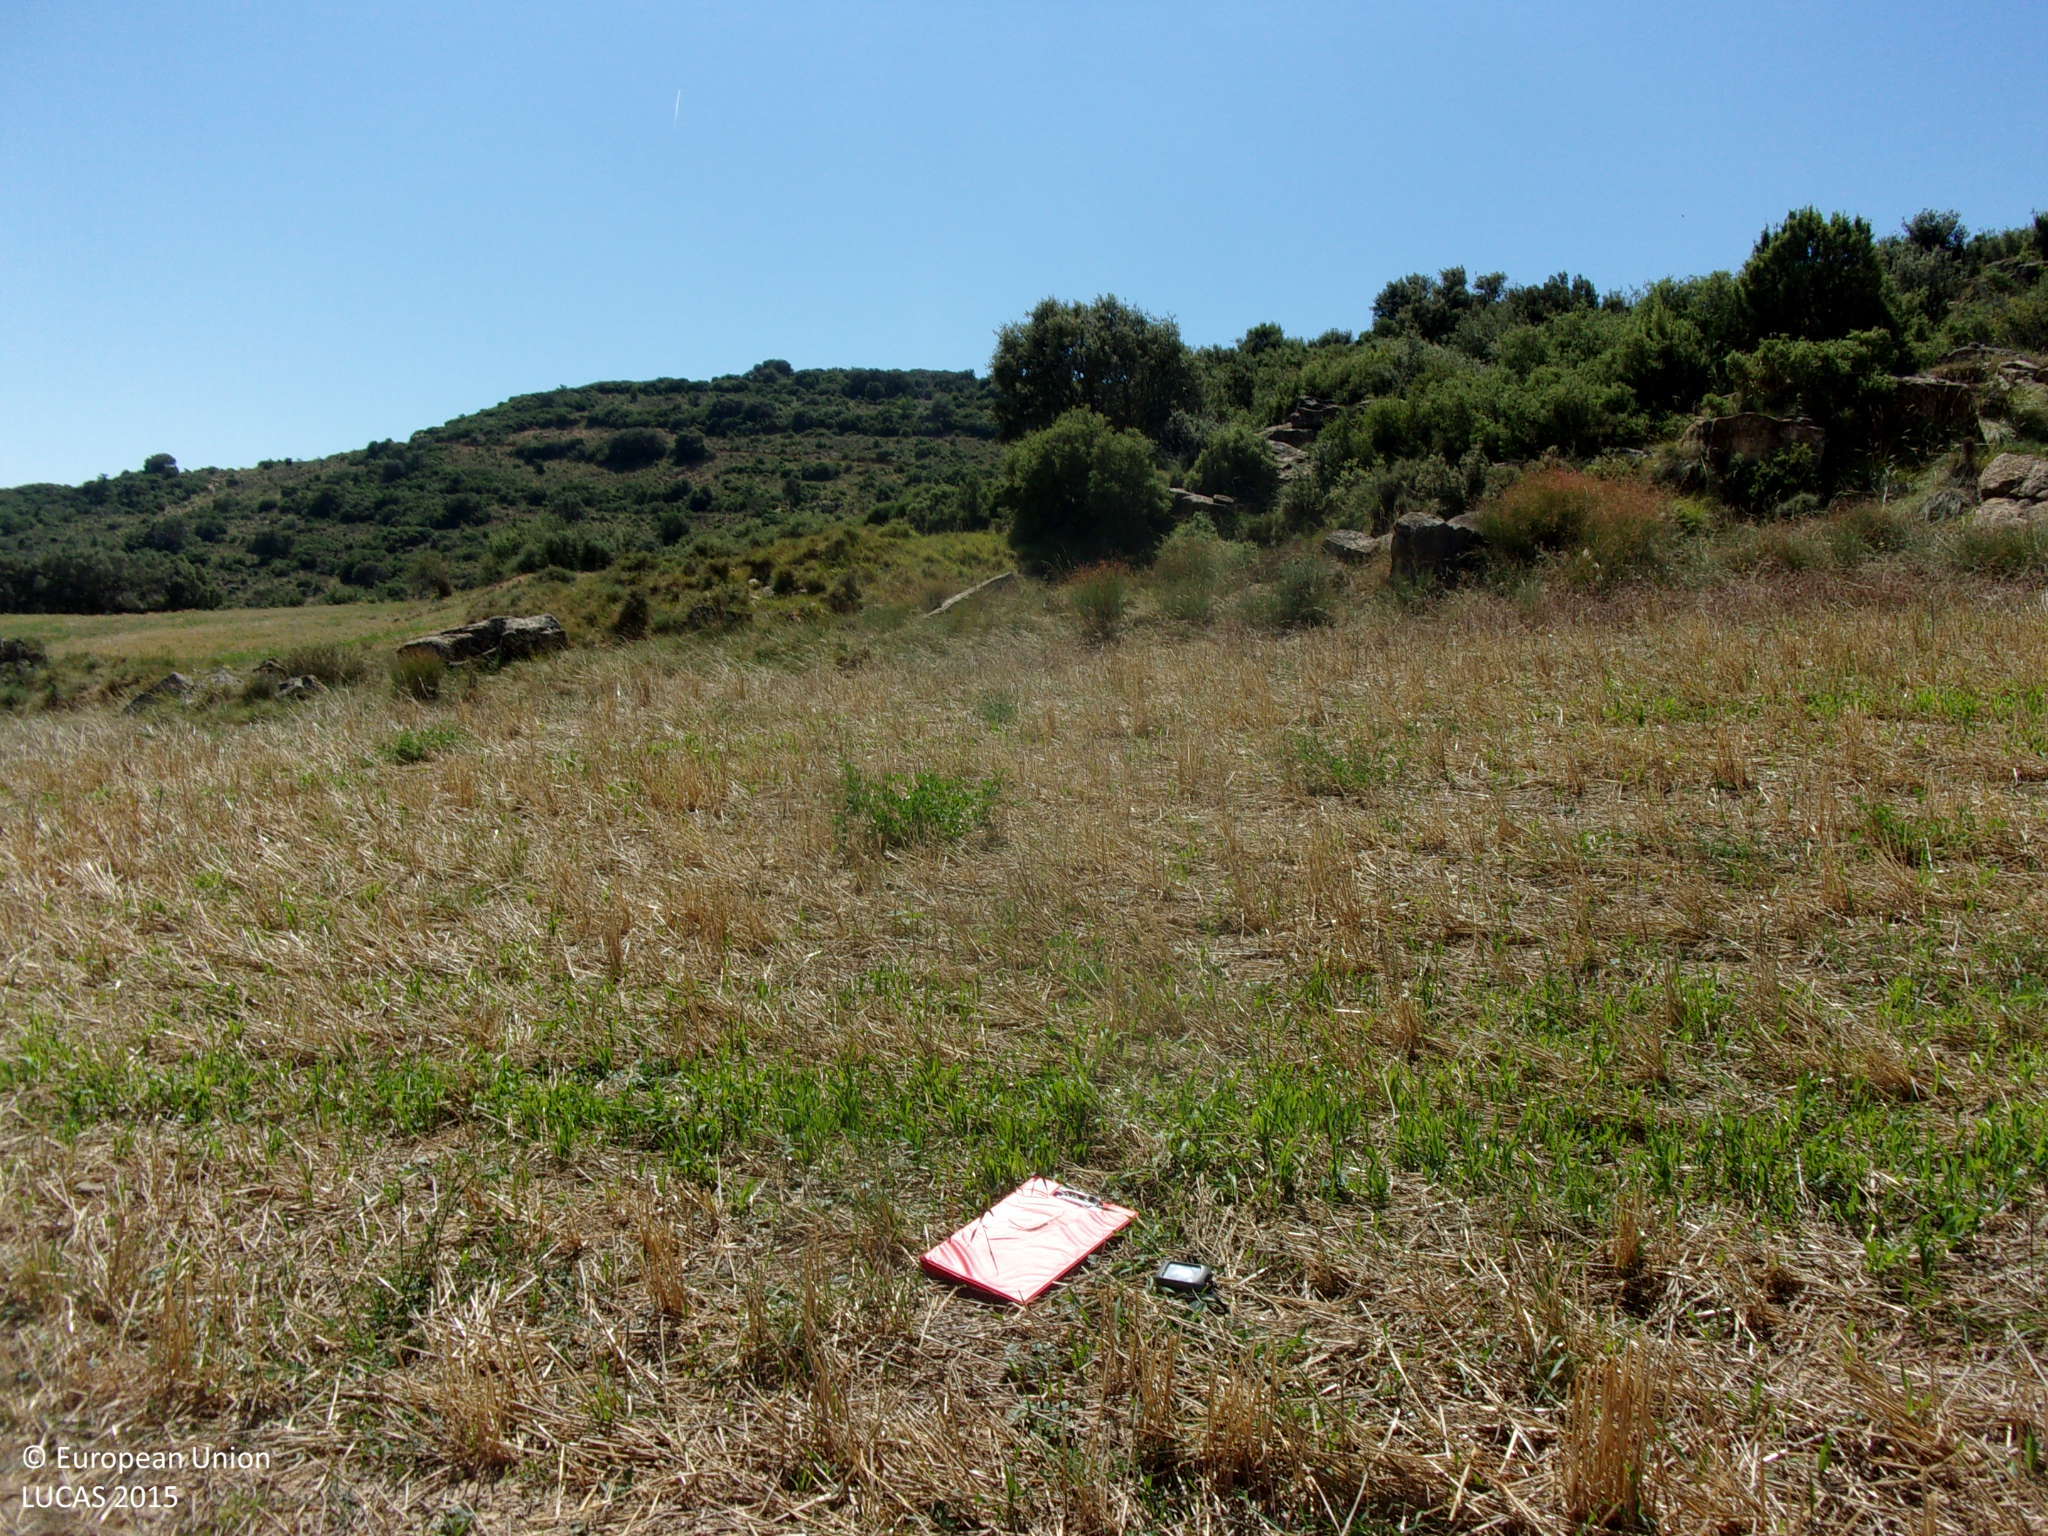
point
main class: Cropland
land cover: Barley
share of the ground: < 10 %
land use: Agriculture (excluding fallow land and kitchen gardens)
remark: Harvested field
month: August
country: ES
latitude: 42.3858
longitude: -1.1200
